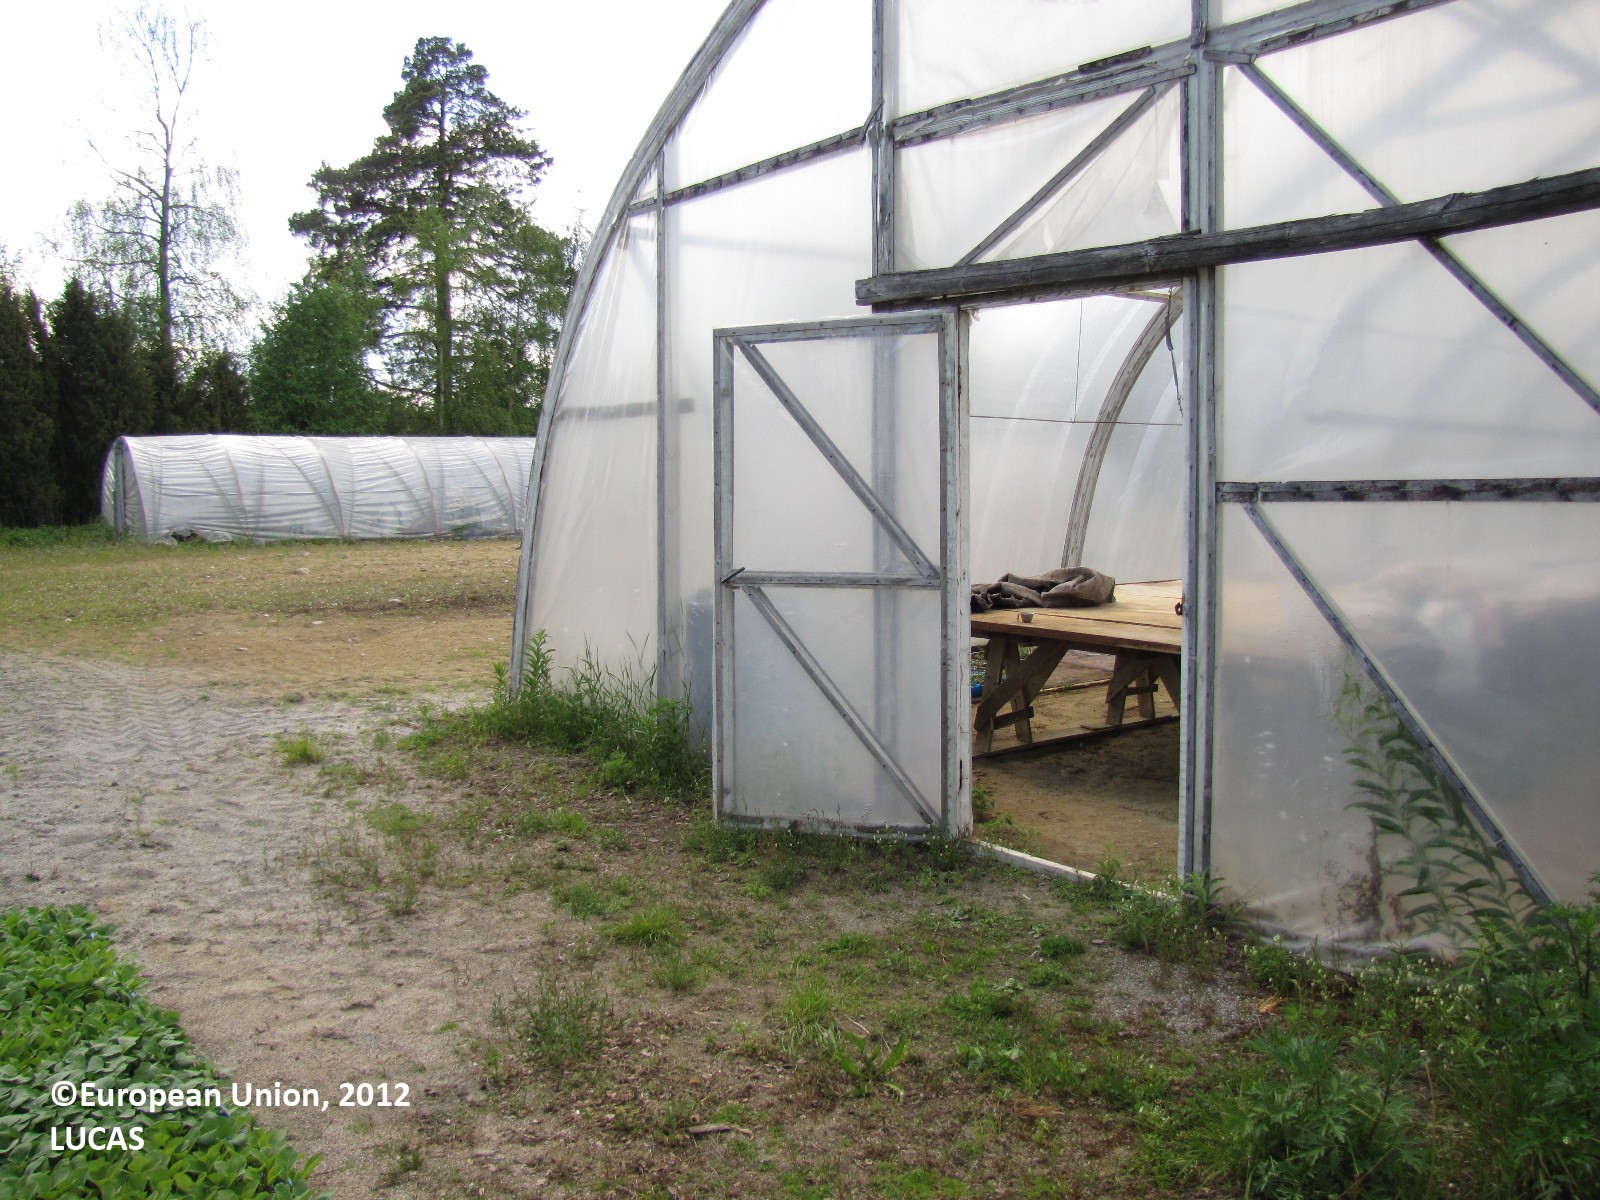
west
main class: Artificial land
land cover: Greenhouses
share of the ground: 25 - 50 %
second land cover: Floriculture and ornamental plants
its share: 25 - 50 %
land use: Agriculture (excluding fallow land and kitchen gardens)
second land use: Fallow land
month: June
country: FI
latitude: 61.2834
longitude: 22.9263
